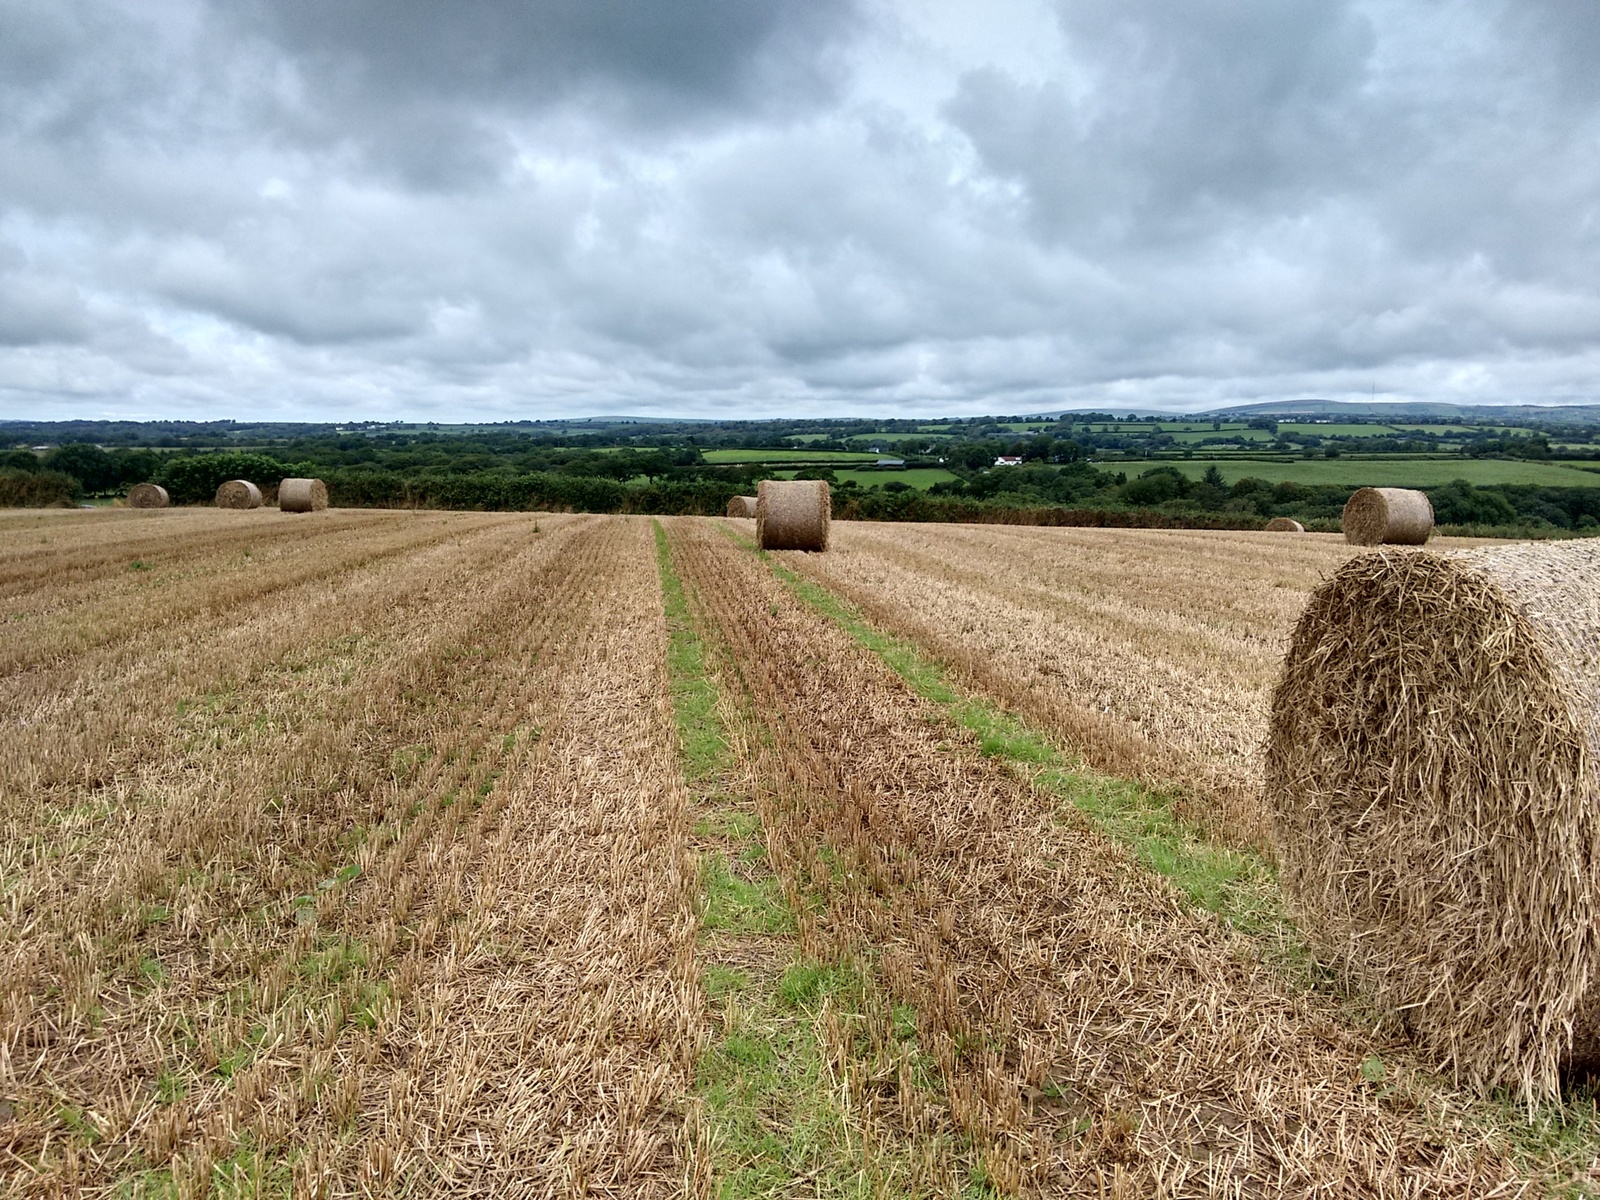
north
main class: Cropland
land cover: Barley
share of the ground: < 10 %
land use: Agriculture (excluding fallow land and kitchen gardens)
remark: Harvested field
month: August
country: GB
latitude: 51.8357
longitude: -4.8734
